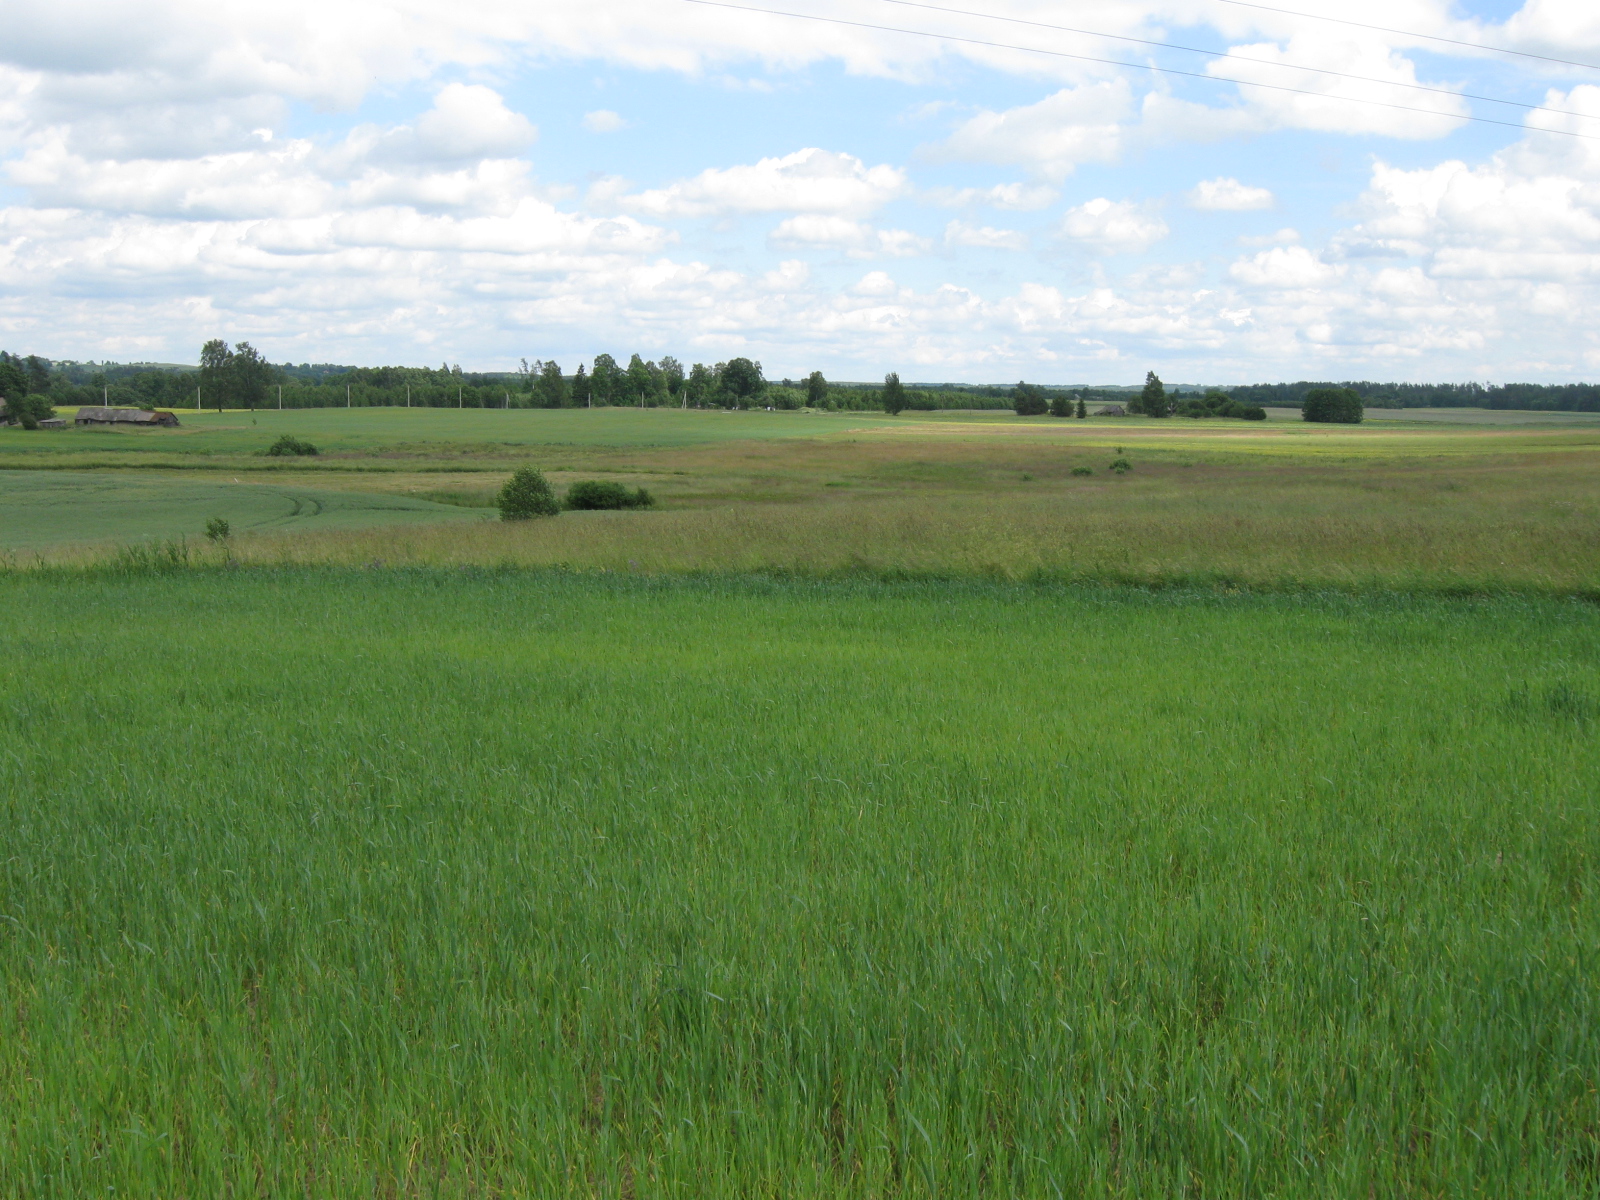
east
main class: Cropland
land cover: Common wheat
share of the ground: > 75 %
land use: Agriculture (excluding fallow land and kitchen gardens)
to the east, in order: Common wheat; Electric lines; Common wheat; Grassland without tree/shrub cover; Single bushes/trees; Grassland without tree/shrub cover; Common wheat; Grassland without tree/shrub cover; Other fibre and oleaginous crops
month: June
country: LT
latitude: 54.5534
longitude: 24.3394
